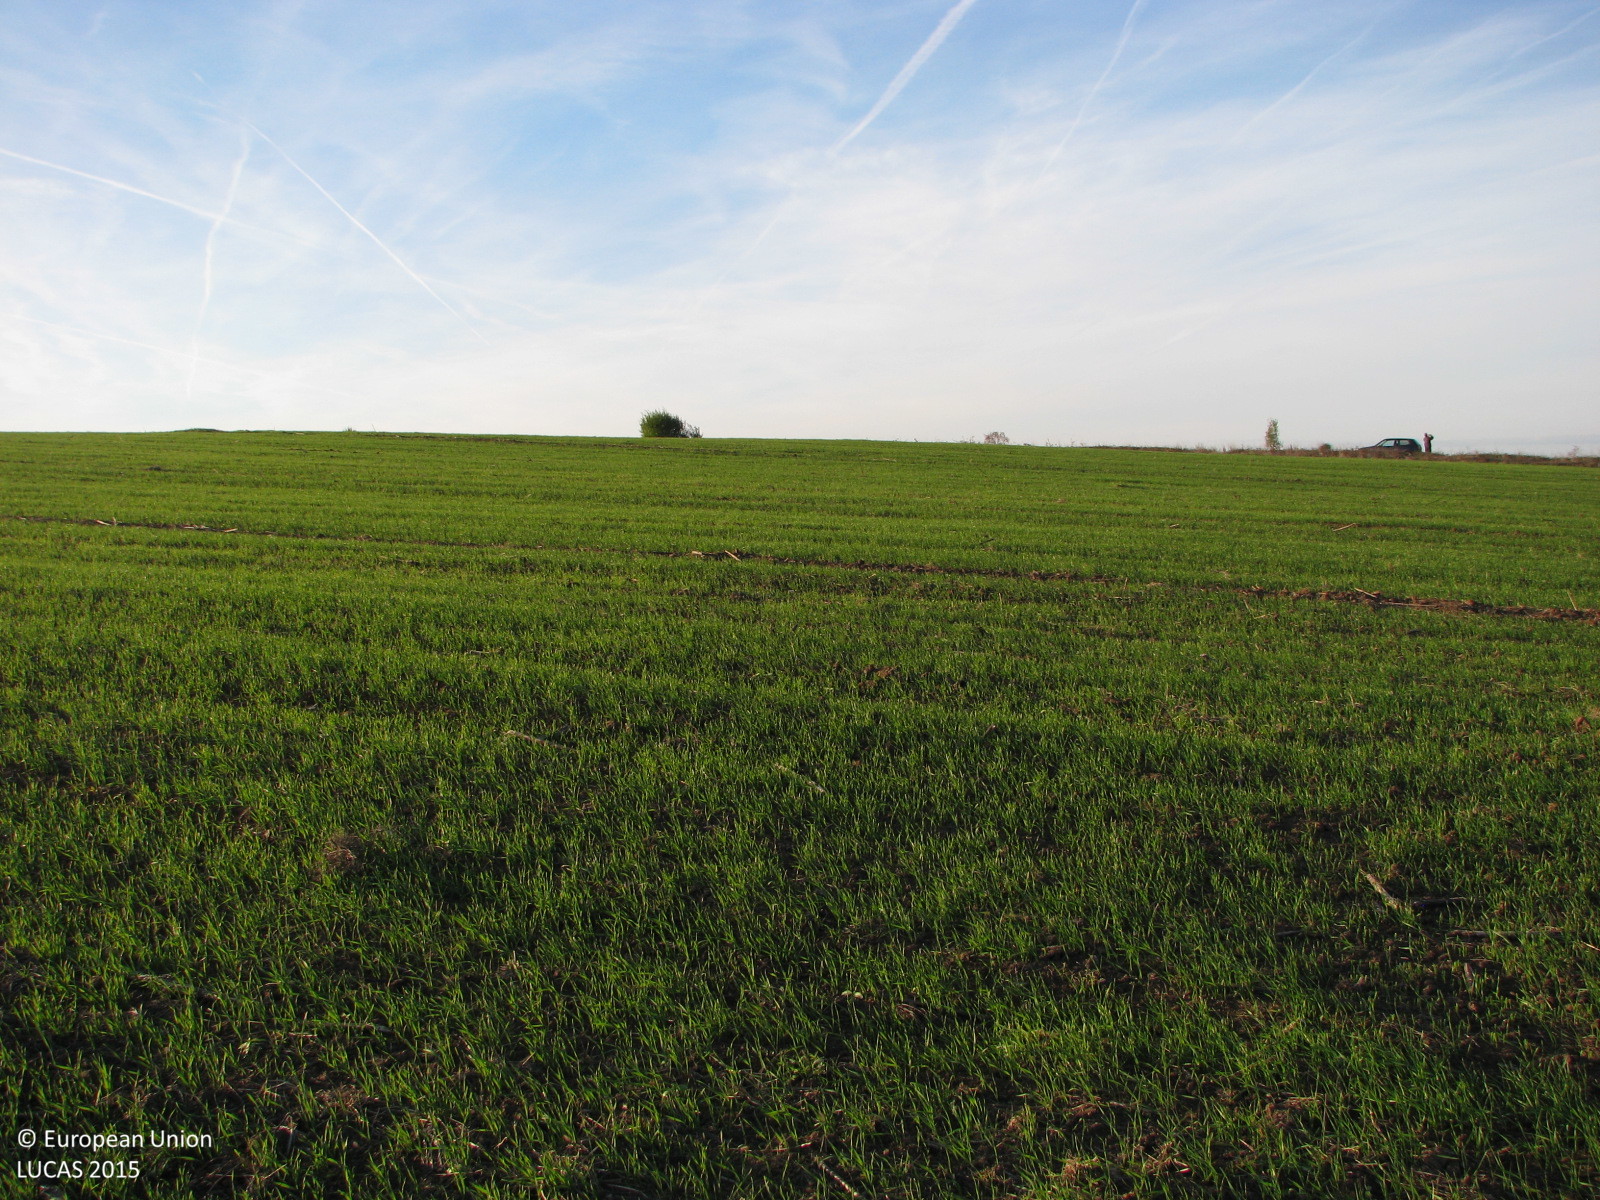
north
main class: Cropland
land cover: Common wheat
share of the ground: > 75 %
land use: Agriculture (excluding fallow land and kitchen gardens)
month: October
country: BG
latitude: 42.2847
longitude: 26.8204
